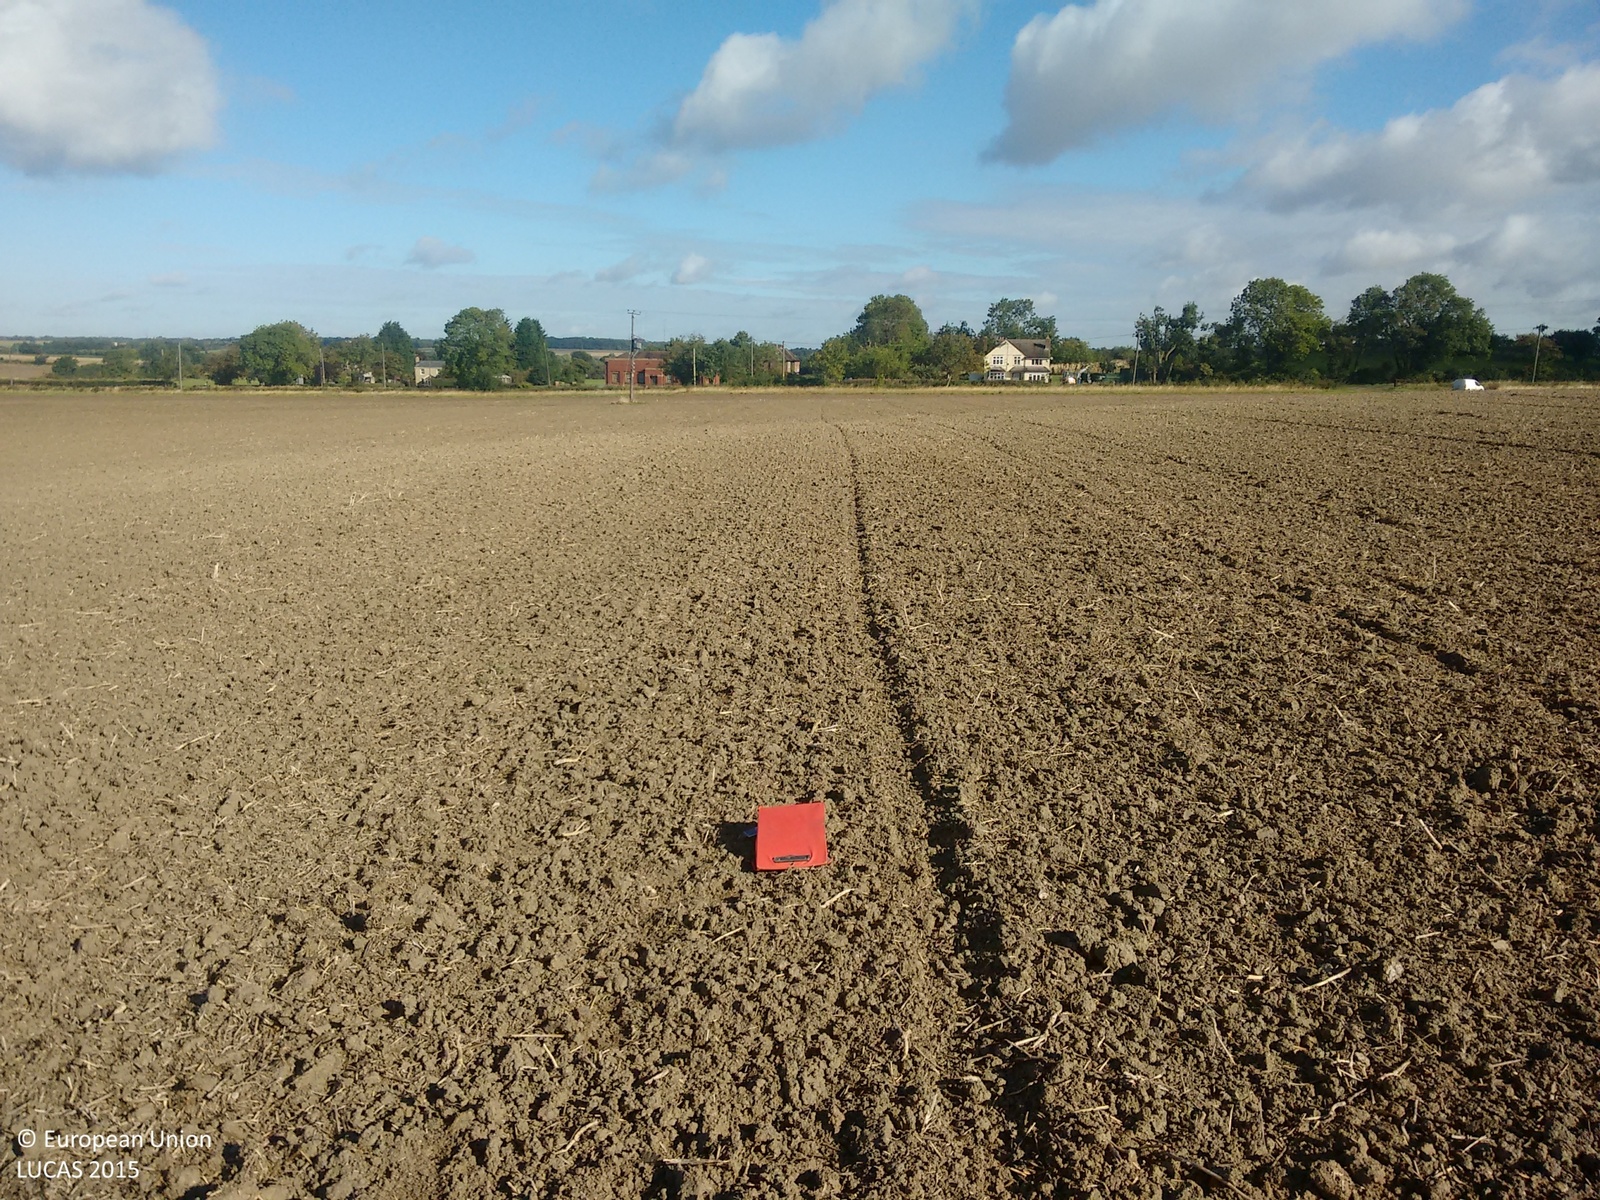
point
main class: Cropland
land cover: Rape and turnip rape
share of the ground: < 10 %
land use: Agriculture (excluding fallow land and kitchen gardens)
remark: Harvested field
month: September
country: GB
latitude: 52.1700
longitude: -0.0193
